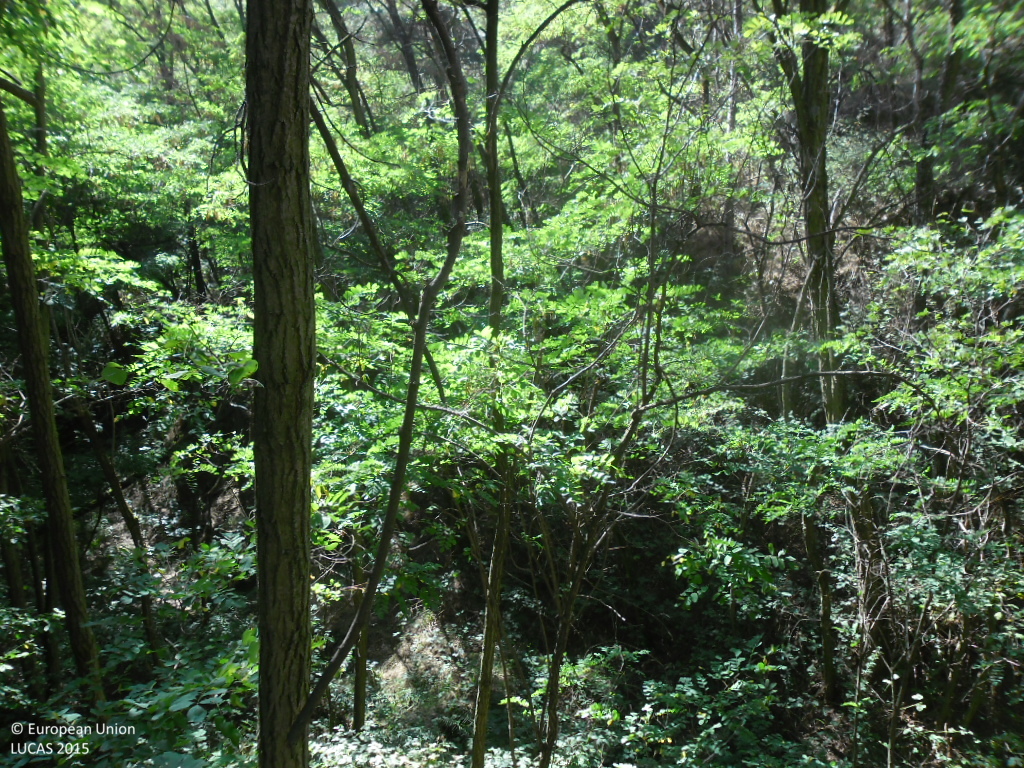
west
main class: Woodland
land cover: Pine dominated coniferous woodland
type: hemiboreal forest and nemoral coniferous forest and mixed broadleaved-coniferous forest
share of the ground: > 75 %
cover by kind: coniferous forest trees 100 %
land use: Forestry
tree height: < 5 m
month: September
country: BG
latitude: 41.8007
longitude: 23.2264
